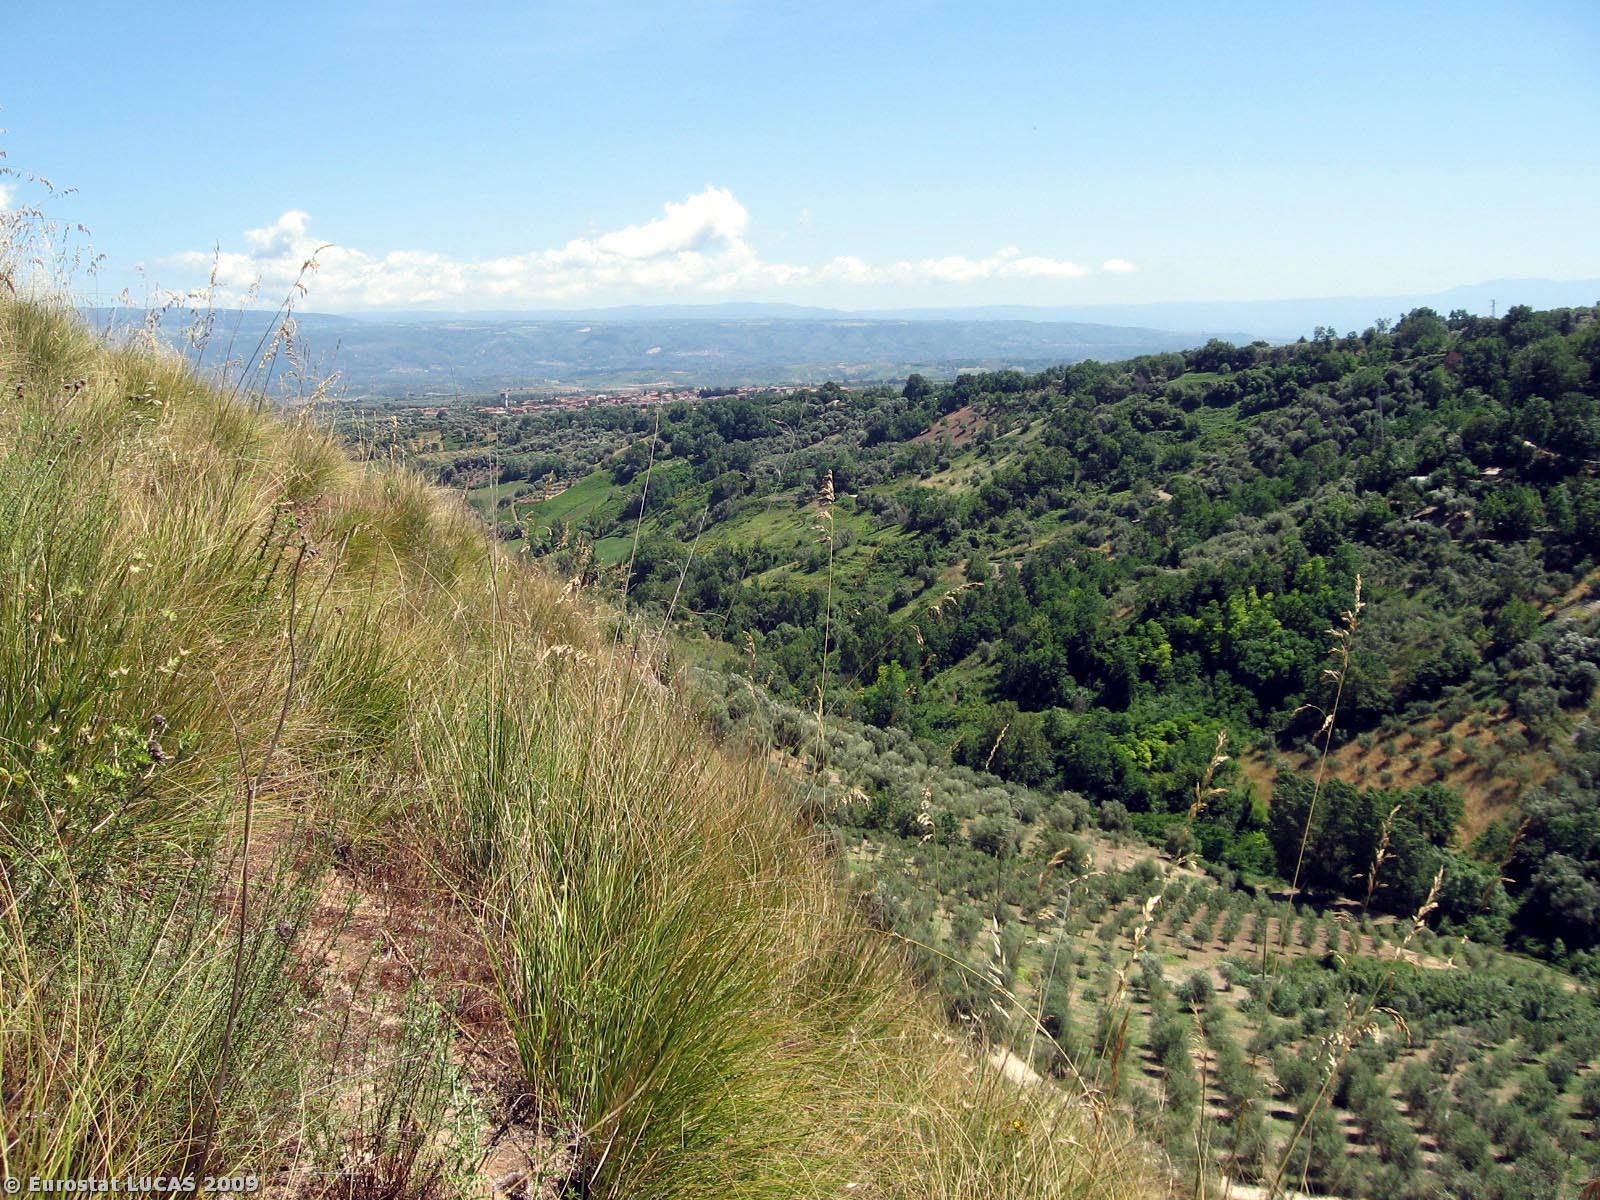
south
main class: Grassland
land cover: Grassland without tree/shrub cover
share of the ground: 50 - 75 %
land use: Unused
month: June
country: IT
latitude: 38.6434
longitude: 16.0895
